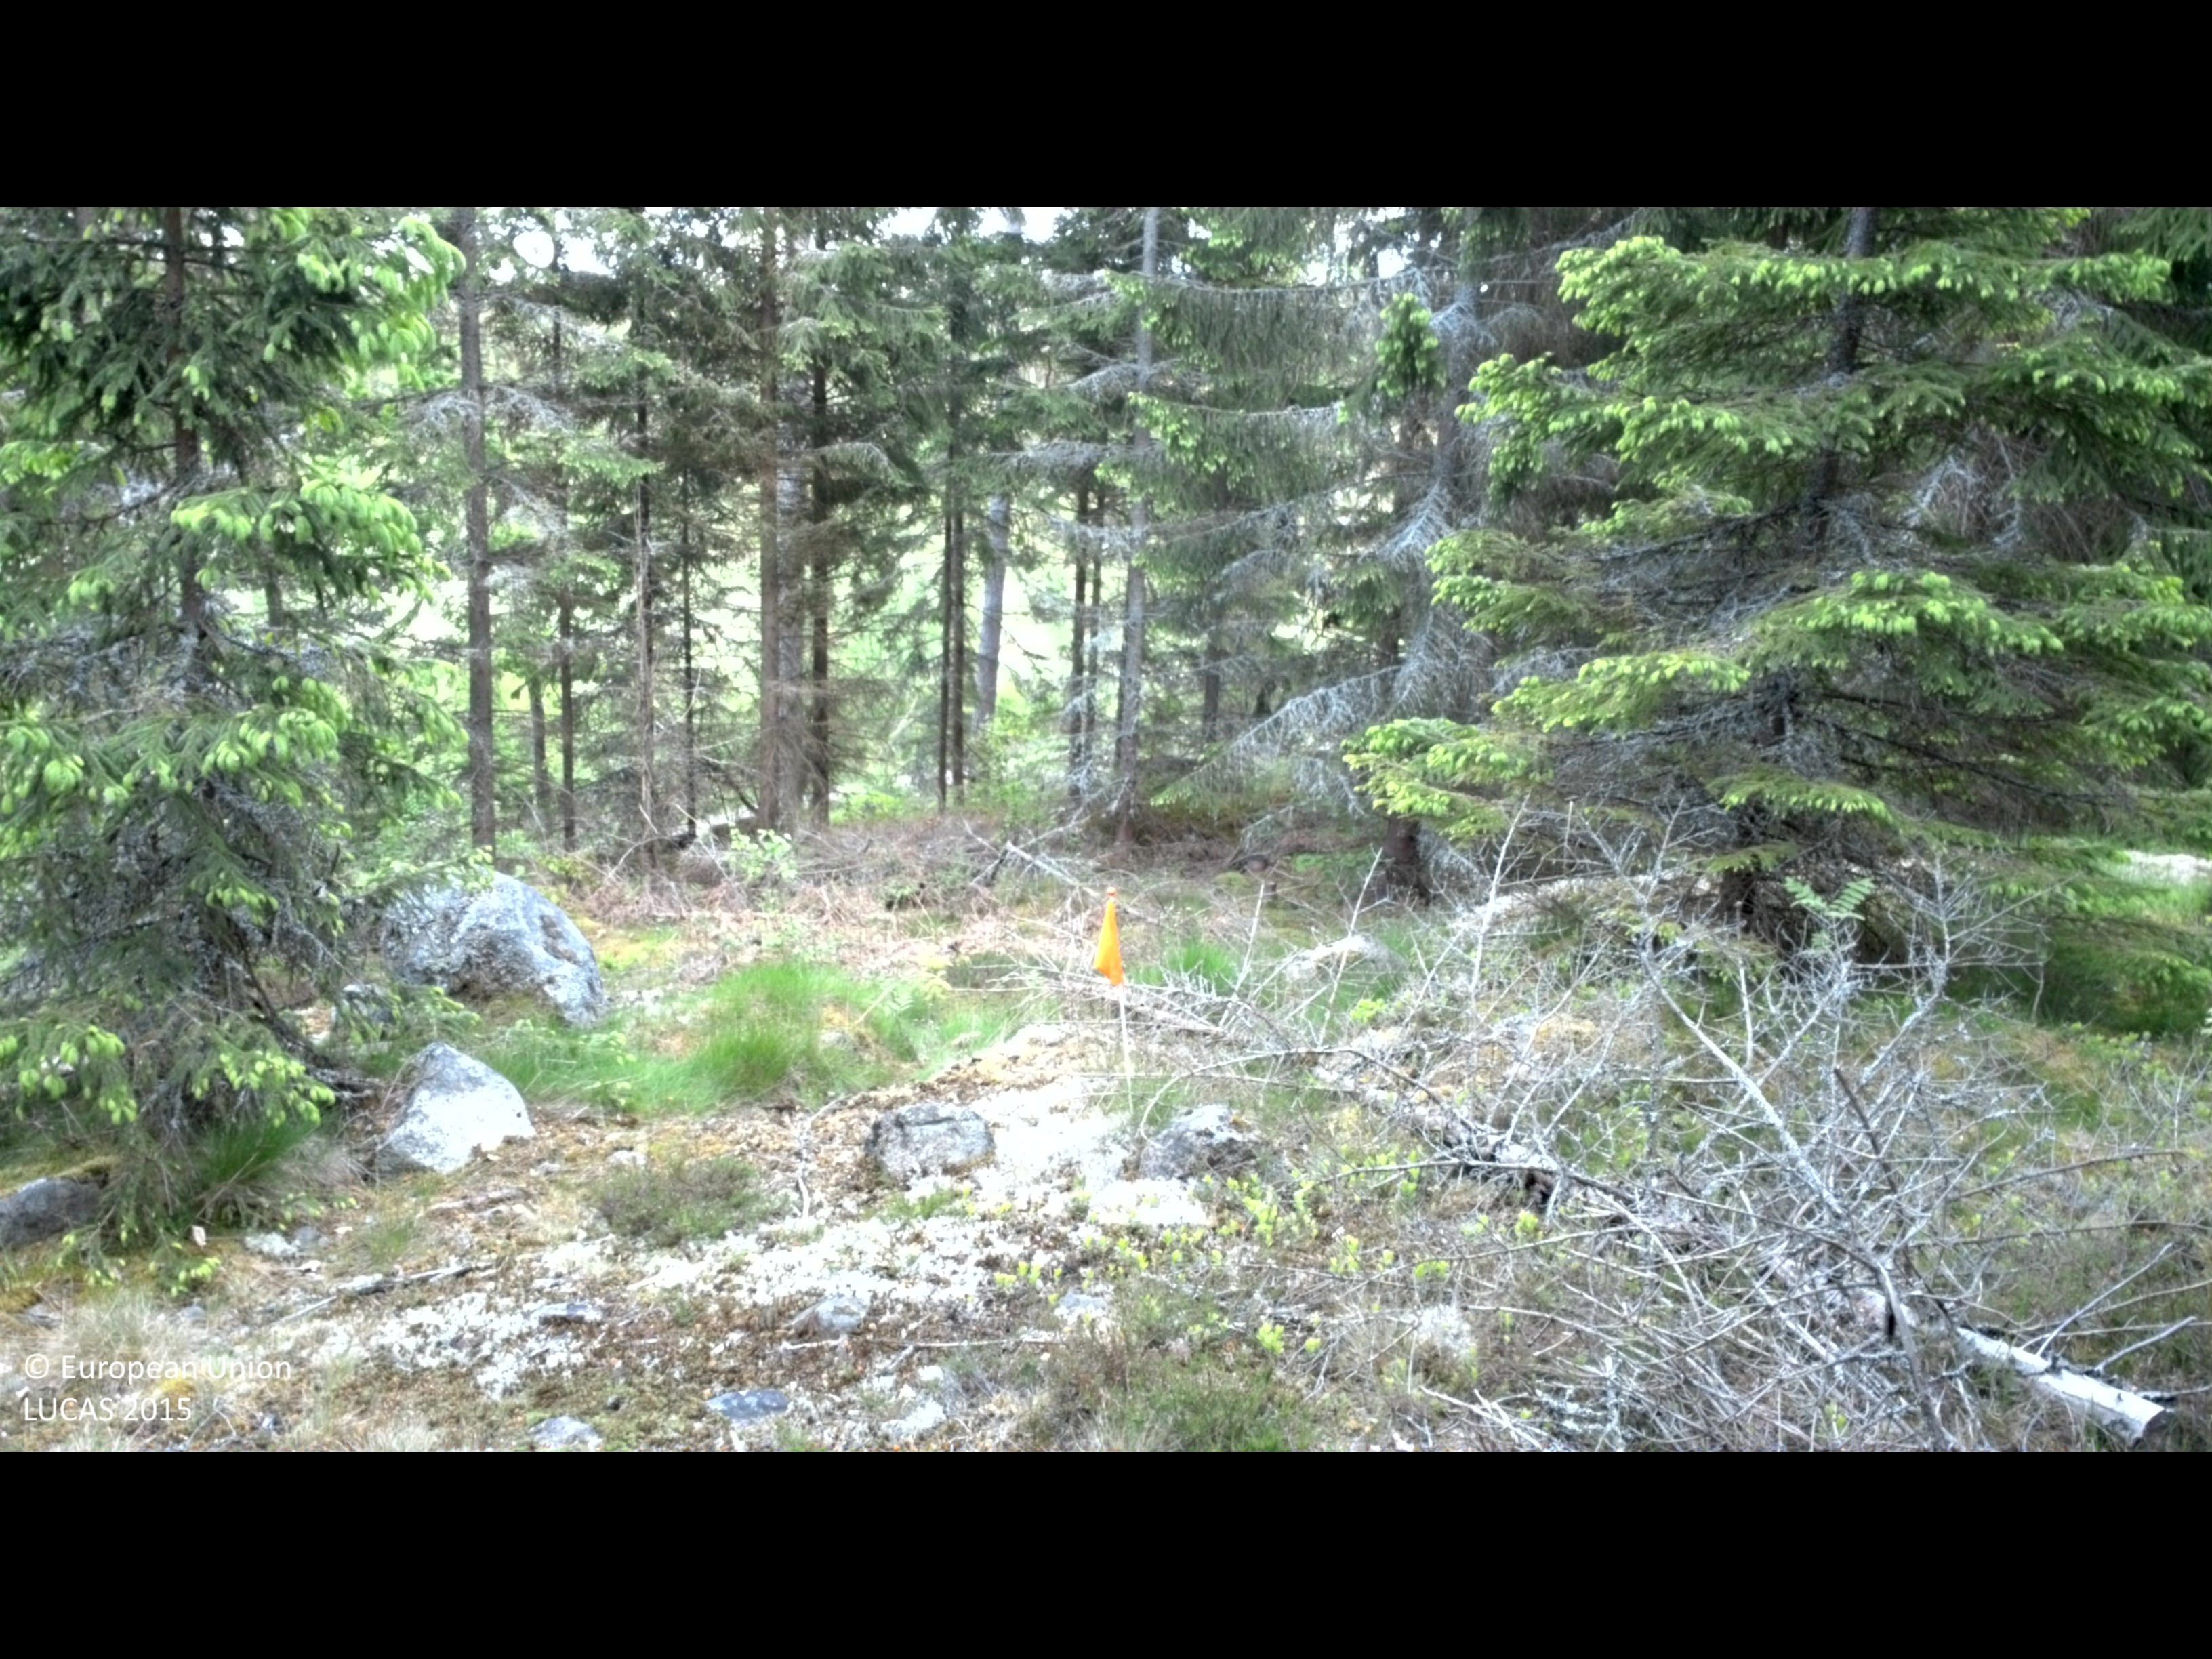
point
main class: Woodland
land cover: Spruce dominated coniferous woodland
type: boreal forest
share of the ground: 25 - 50 %
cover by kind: coniferous forest trees 40 %, shrubs 35 %, lichens and mosses 20 %, broadleaved forest trees 5 %
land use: Forestry
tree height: > 5 m
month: June
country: SE
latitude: 57.7860
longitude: 16.2375
